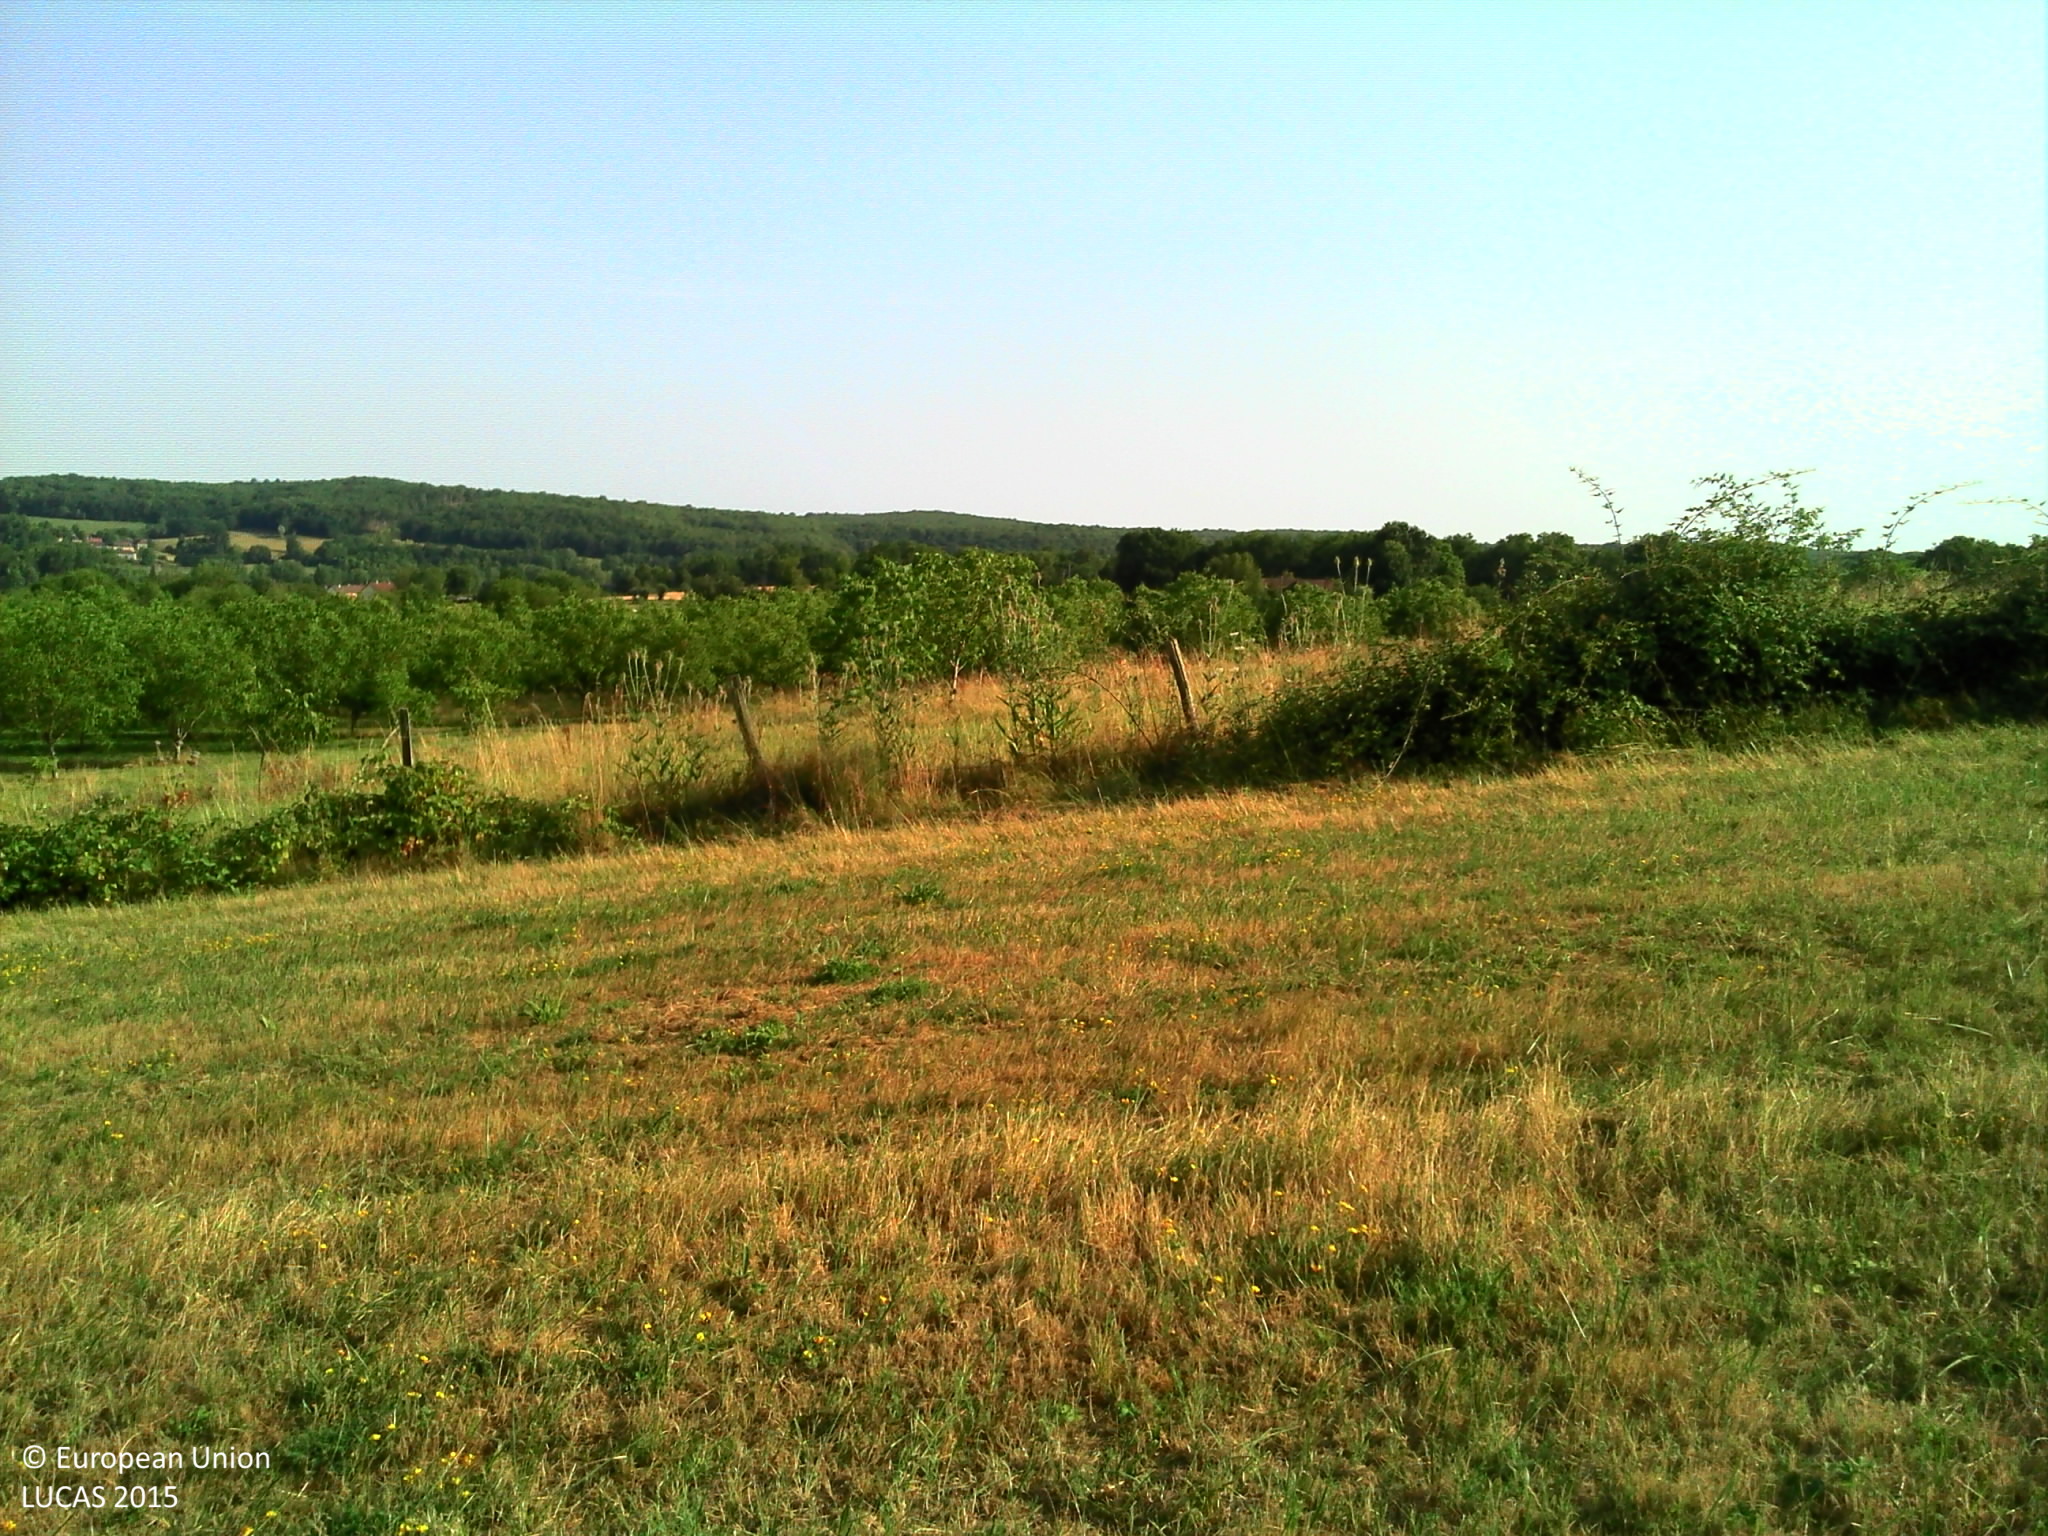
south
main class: Grassland
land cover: Grassland without tree/shrub cover
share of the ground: > 75 %
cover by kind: herbaceous plants 100 %
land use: Agriculture (excluding fallow land and kitchen gardens)
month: July
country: FR
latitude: 45.2893
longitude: 1.0797
